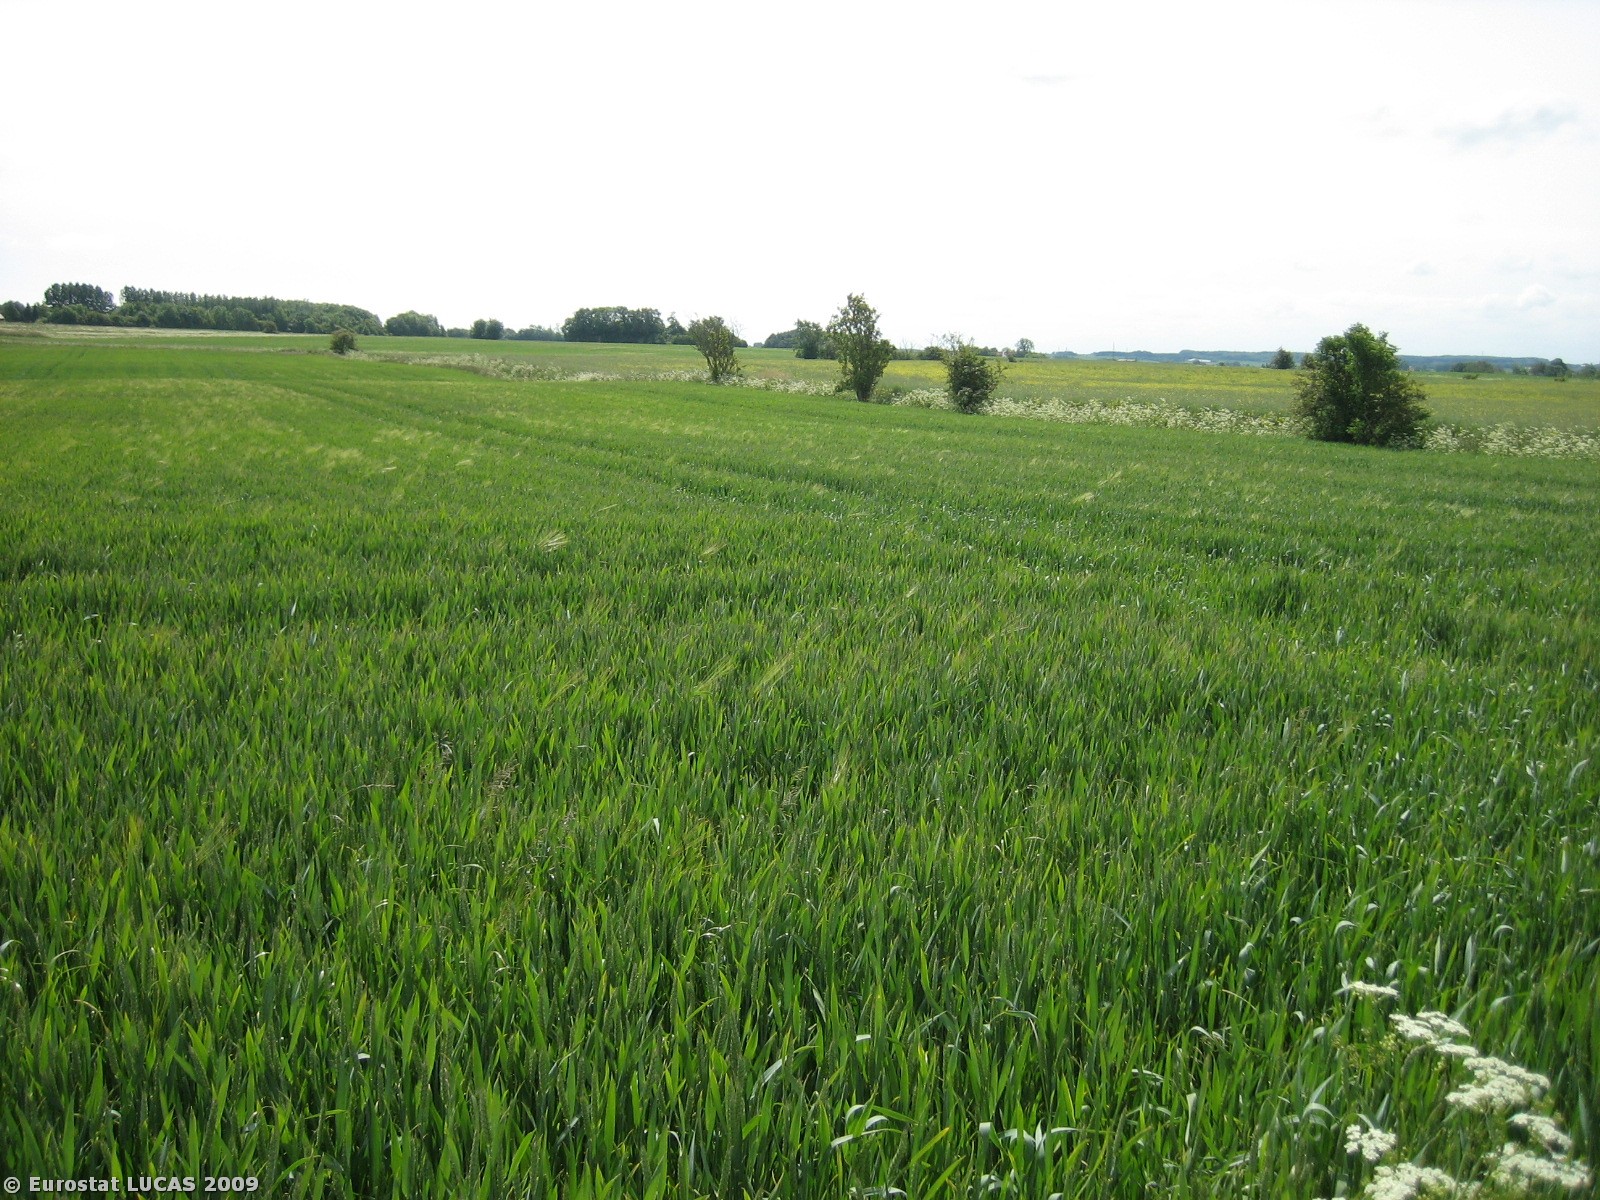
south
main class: Cropland
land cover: Common wheat
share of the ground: > 75 %
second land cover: Barley
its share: < 10 %
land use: Agriculture (excluding fallow land and kitchen gardens)
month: June
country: DK
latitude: 56.2954
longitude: 10.2098
